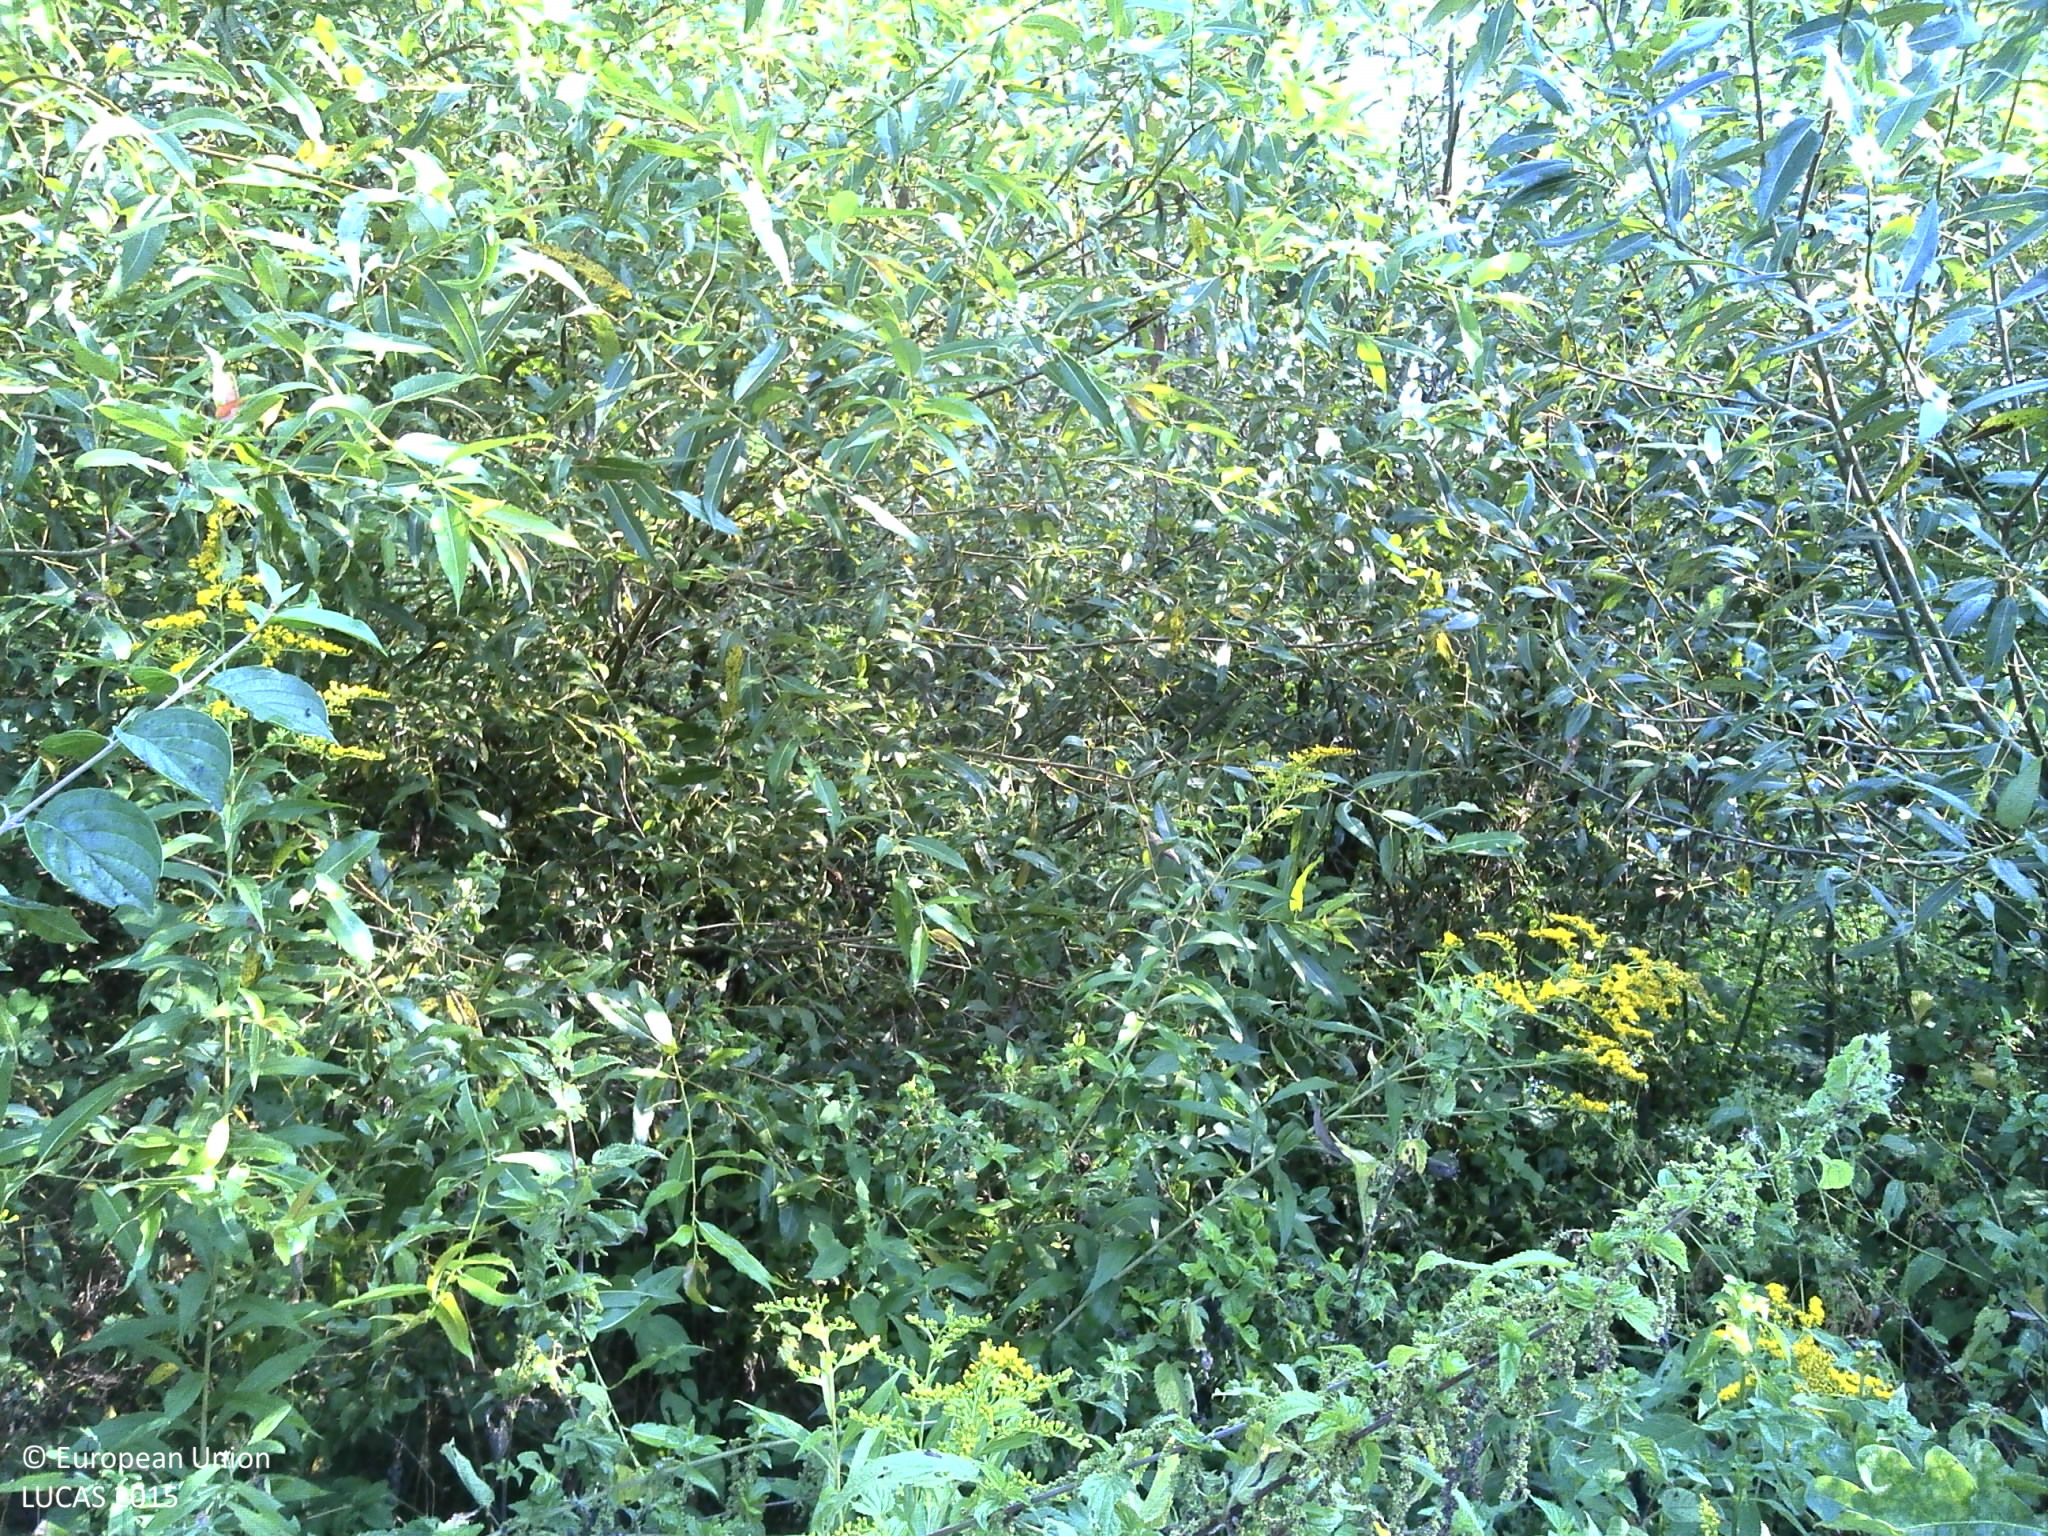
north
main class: Shrubland
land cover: Shrubland without tree cover
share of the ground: > 75 %
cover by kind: shrubs 100 %
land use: Forestry
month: August
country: HR
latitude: 45.6409
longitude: 16.8893
